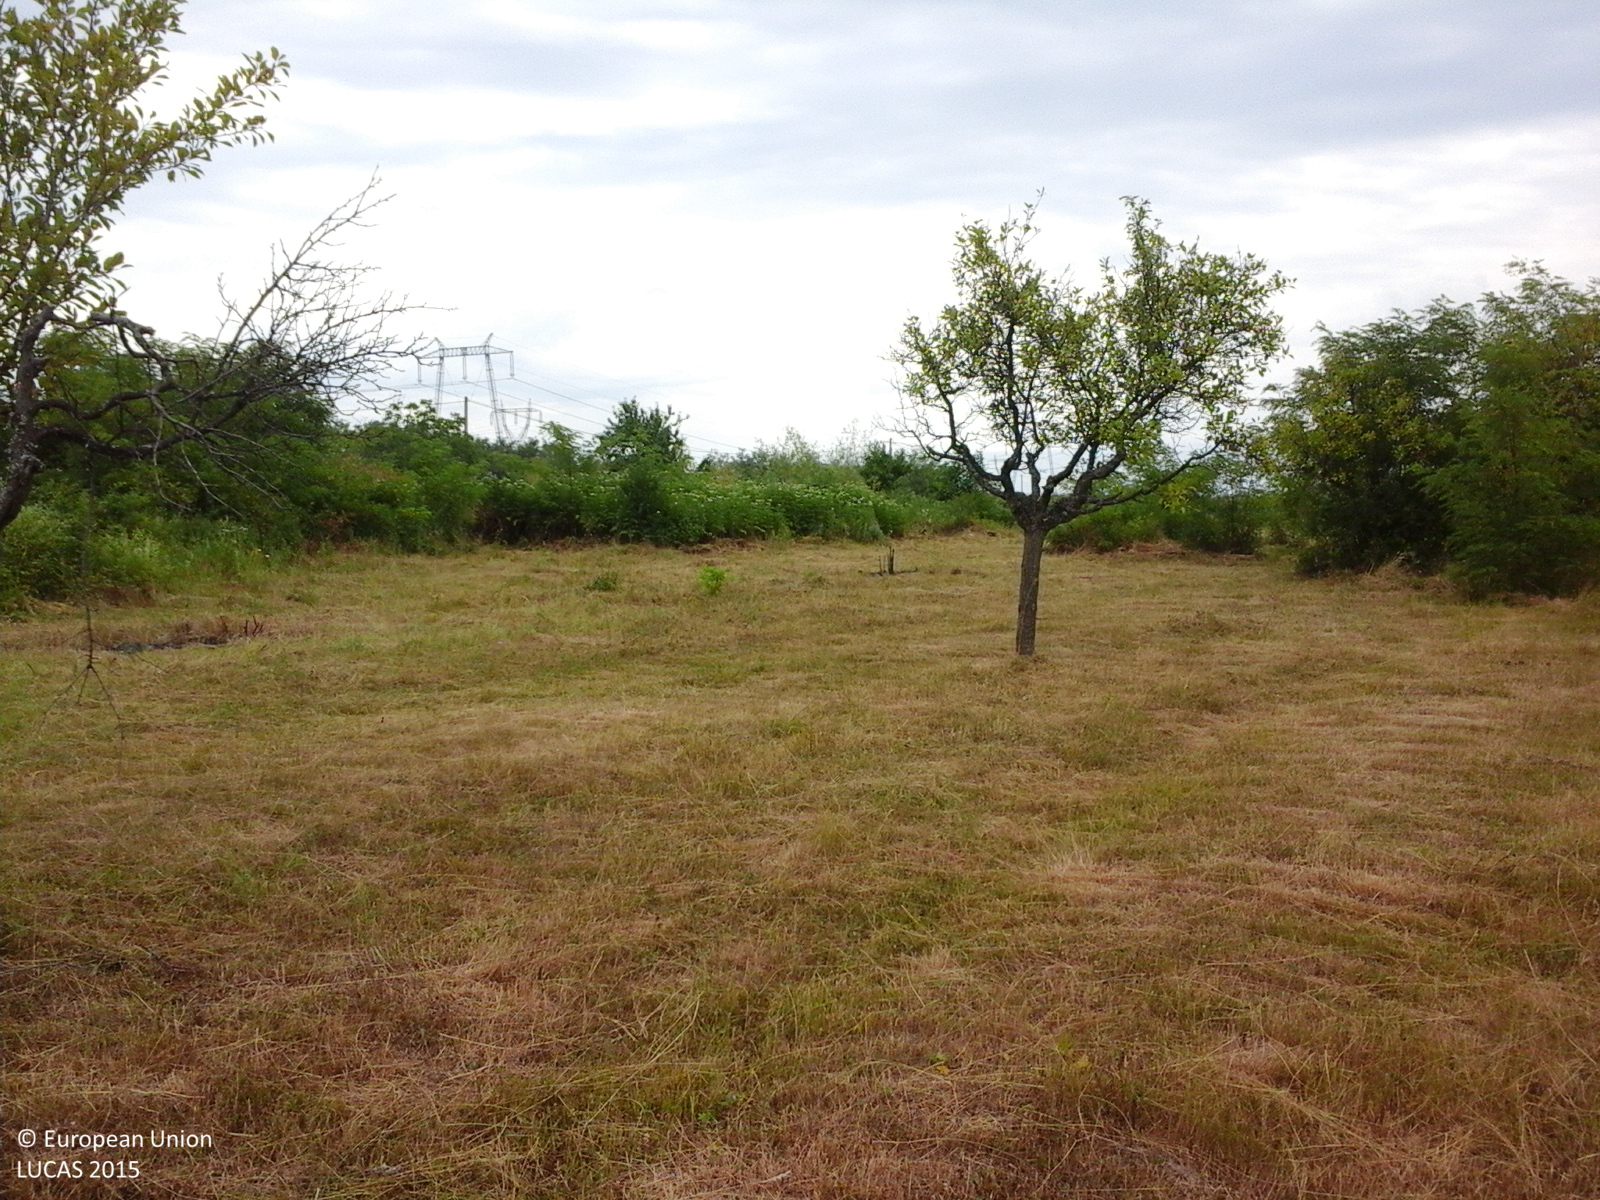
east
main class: Cropland
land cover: Other fruit trees and berries
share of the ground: > 75 %
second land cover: Grassland without tree/shrub cover
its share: > 75 %
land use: Agriculture (excluding fallow land and kitchen gardens)
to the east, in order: Other fruit trees and berries; Grassland without tree/shrub cover; Single bushes/trees; Fences; Grass margins; Paved roads, cycling and walking lanes; Shrubland with sparse tree cover; Electric lines; Maize; Other fruit trees and berries; Tracks; Other fruit trees and berries
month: July
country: RO
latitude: 44.8007
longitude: 24.4210
